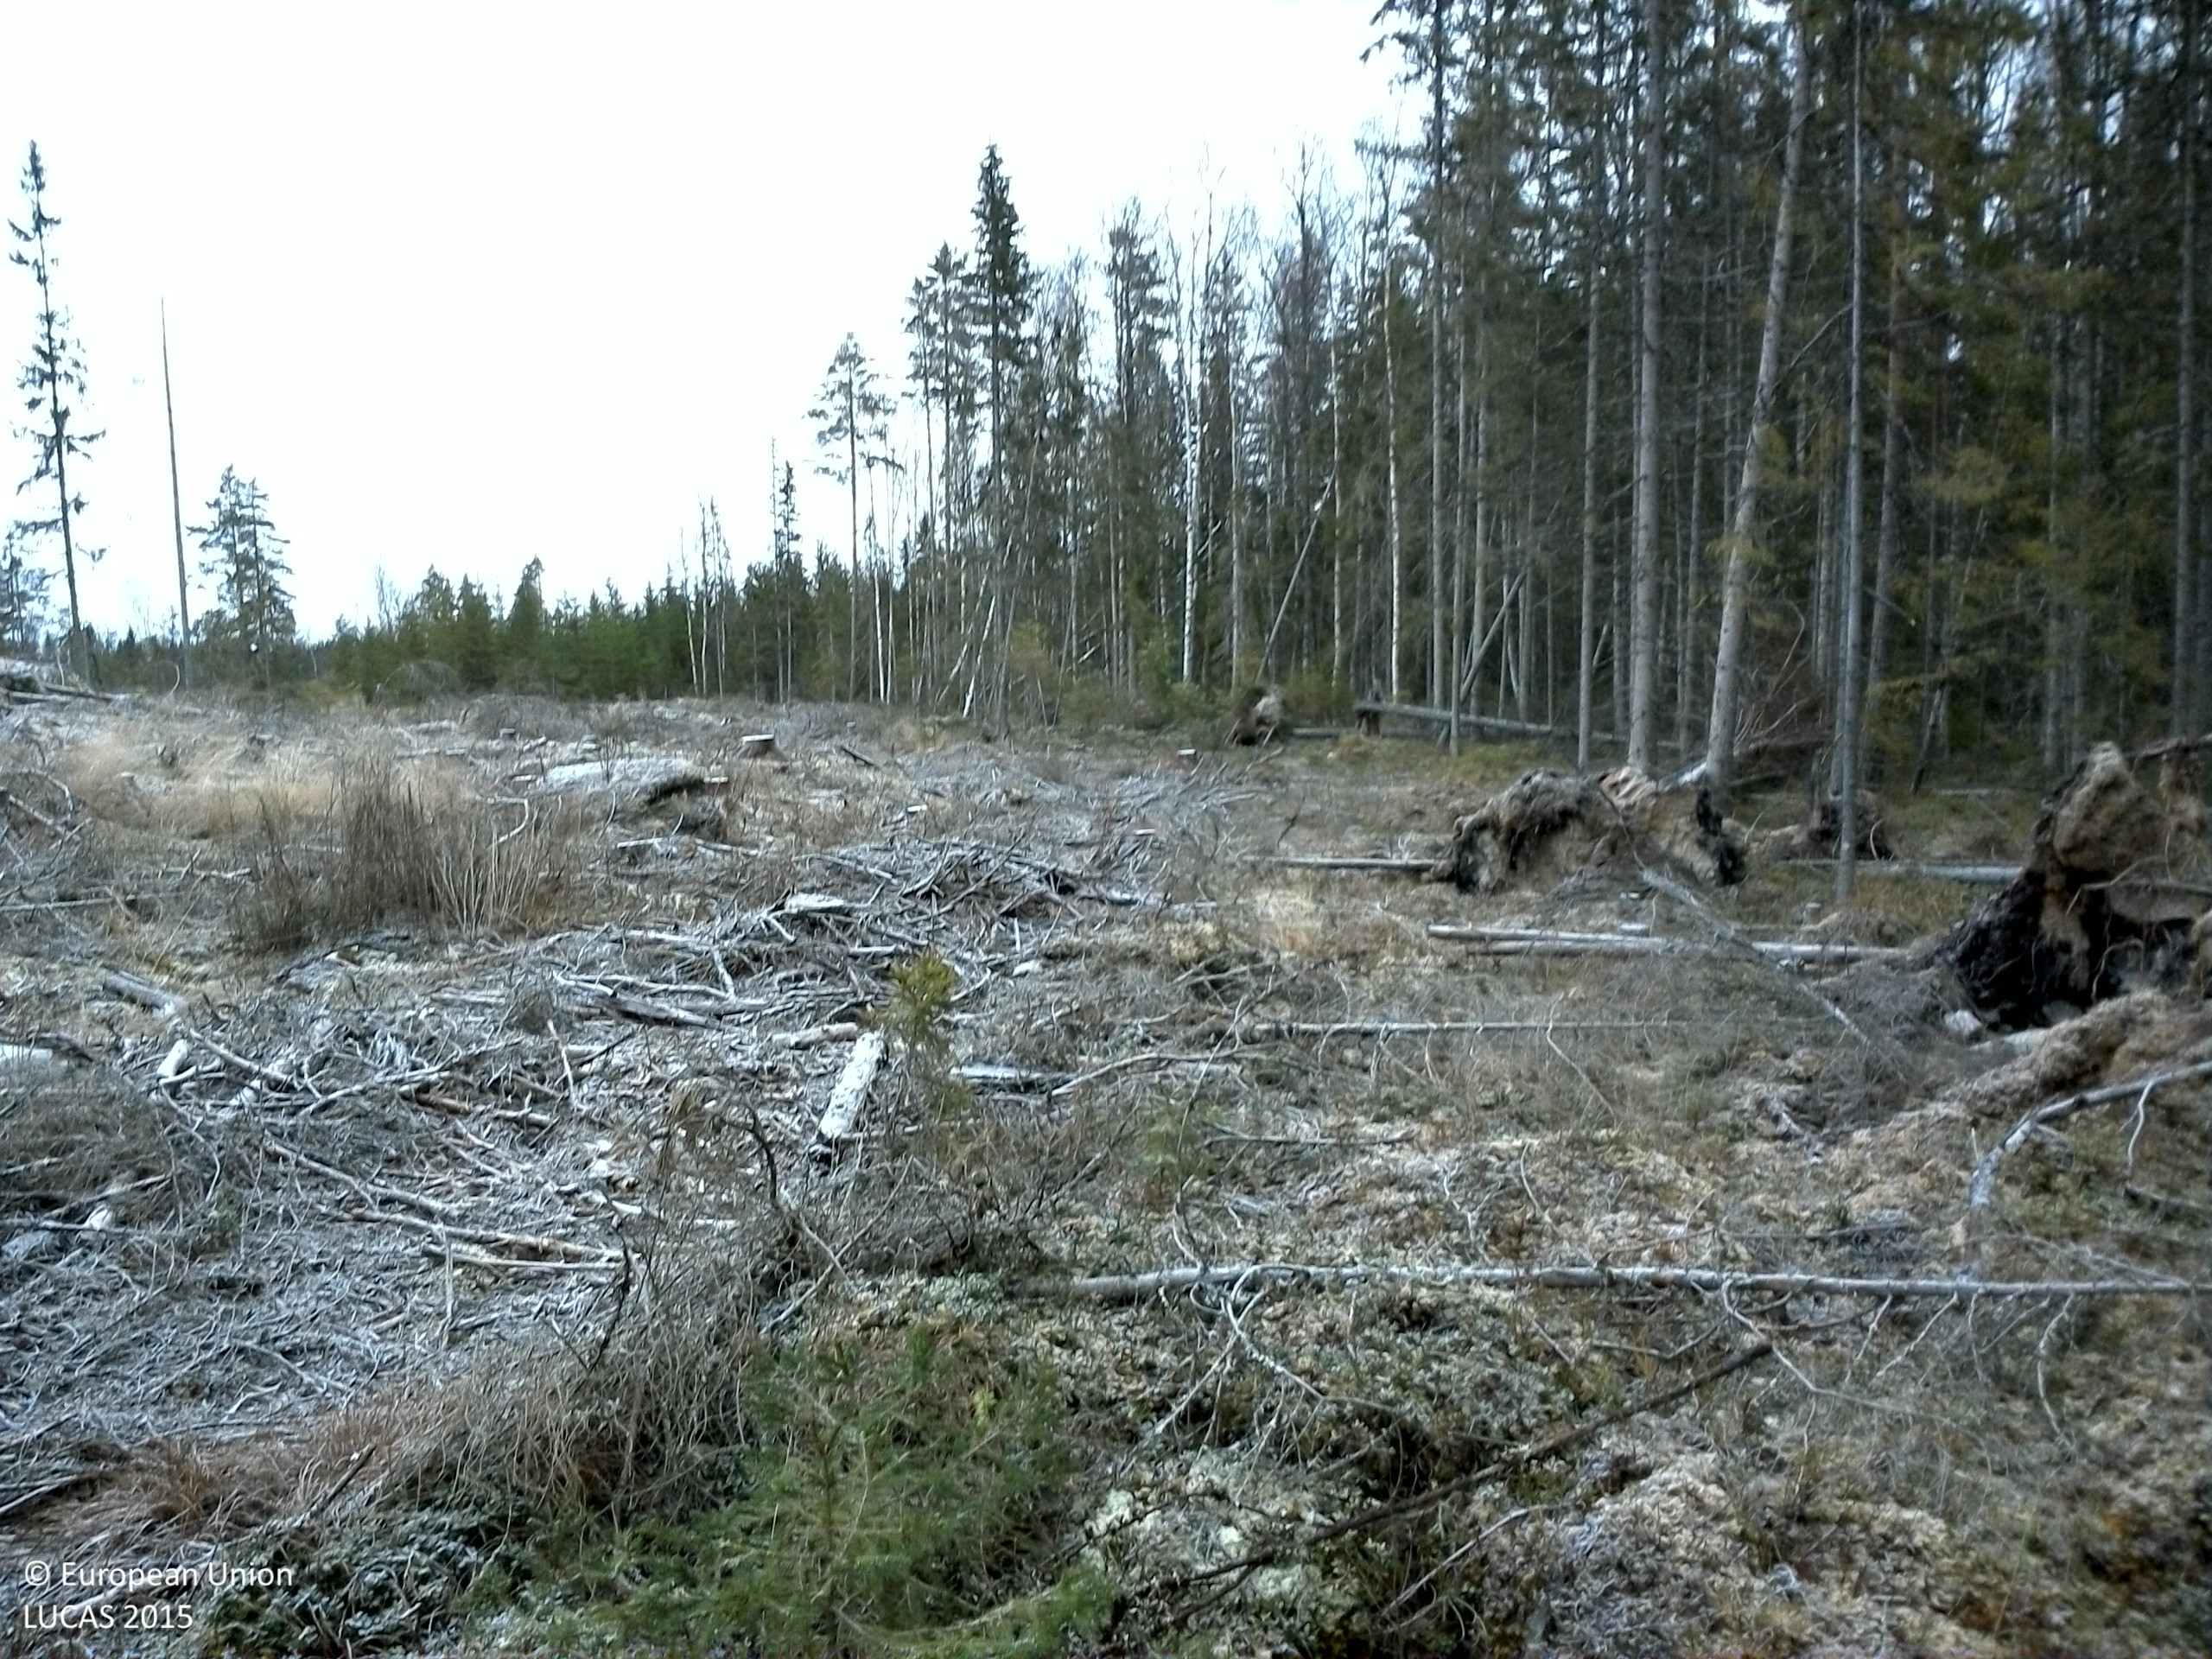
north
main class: Shrubland
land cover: Shrubland without tree cover
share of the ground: 25 - 50 %
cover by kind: shrubs 40 %, consolidated bare surface 30 %, herbaceous plants 15 %, lichens and mosses 15 %
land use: Forestry
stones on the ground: 10 - 25 %
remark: Clear cut
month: November
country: SE
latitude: 60.1393
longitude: 15.6609
